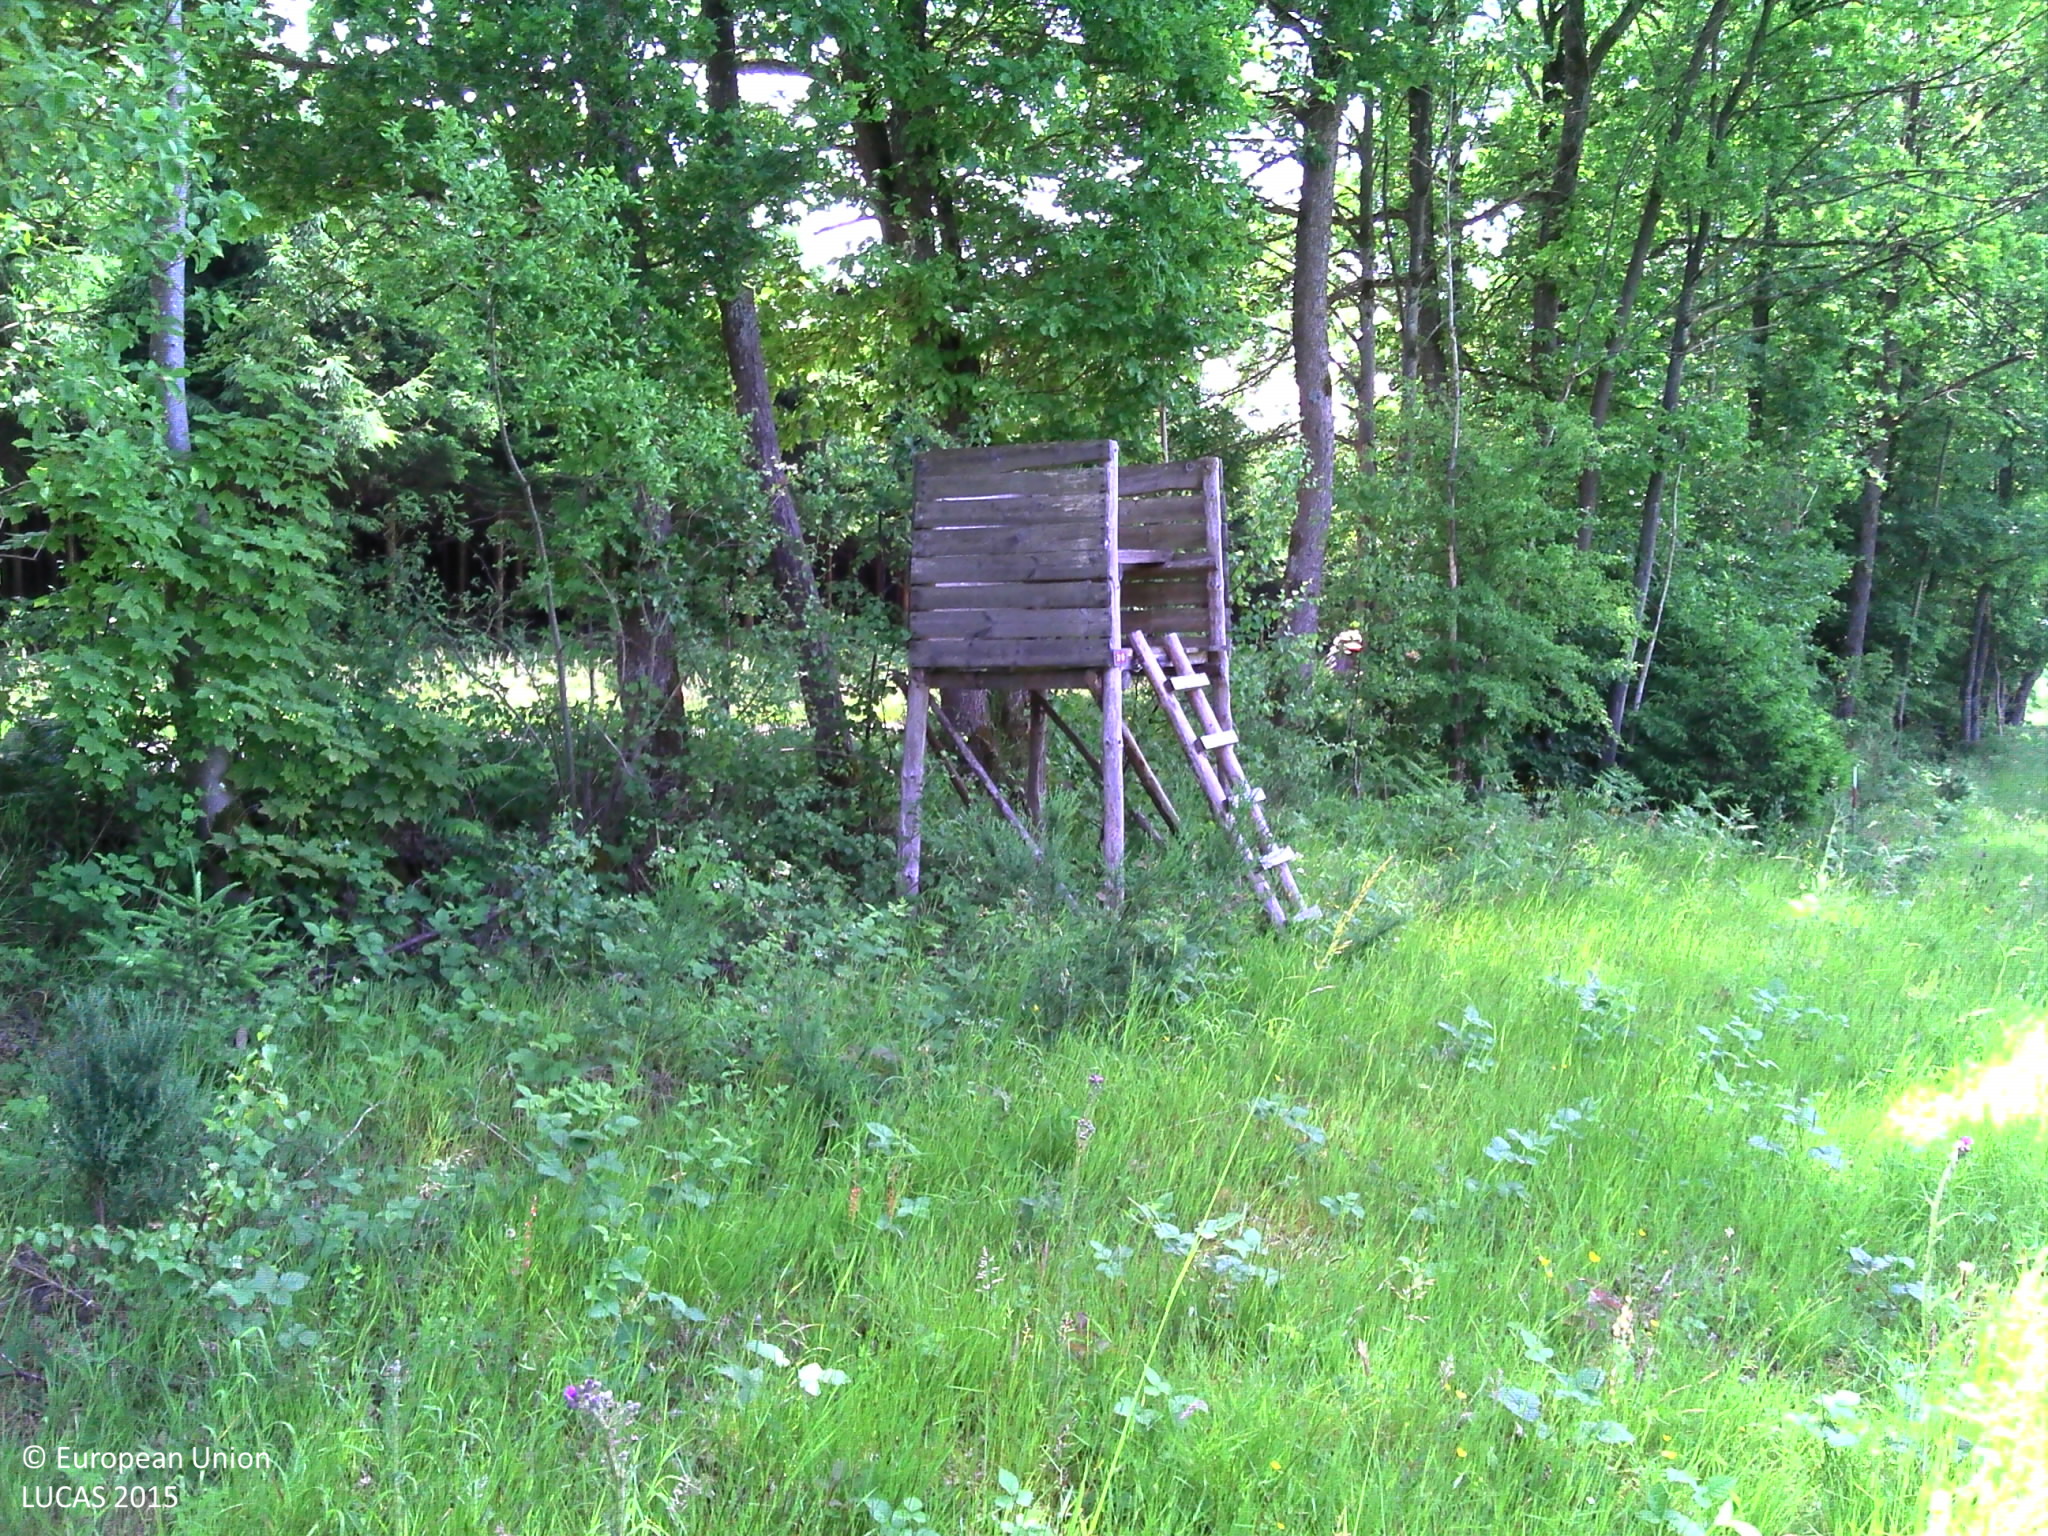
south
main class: Grassland
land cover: Spontaneously vegetated surfaces
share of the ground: > 75 %
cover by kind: herbaceous plants 100 %
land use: Forestry
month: June
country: BE
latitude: 49.9960
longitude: 5.2688
